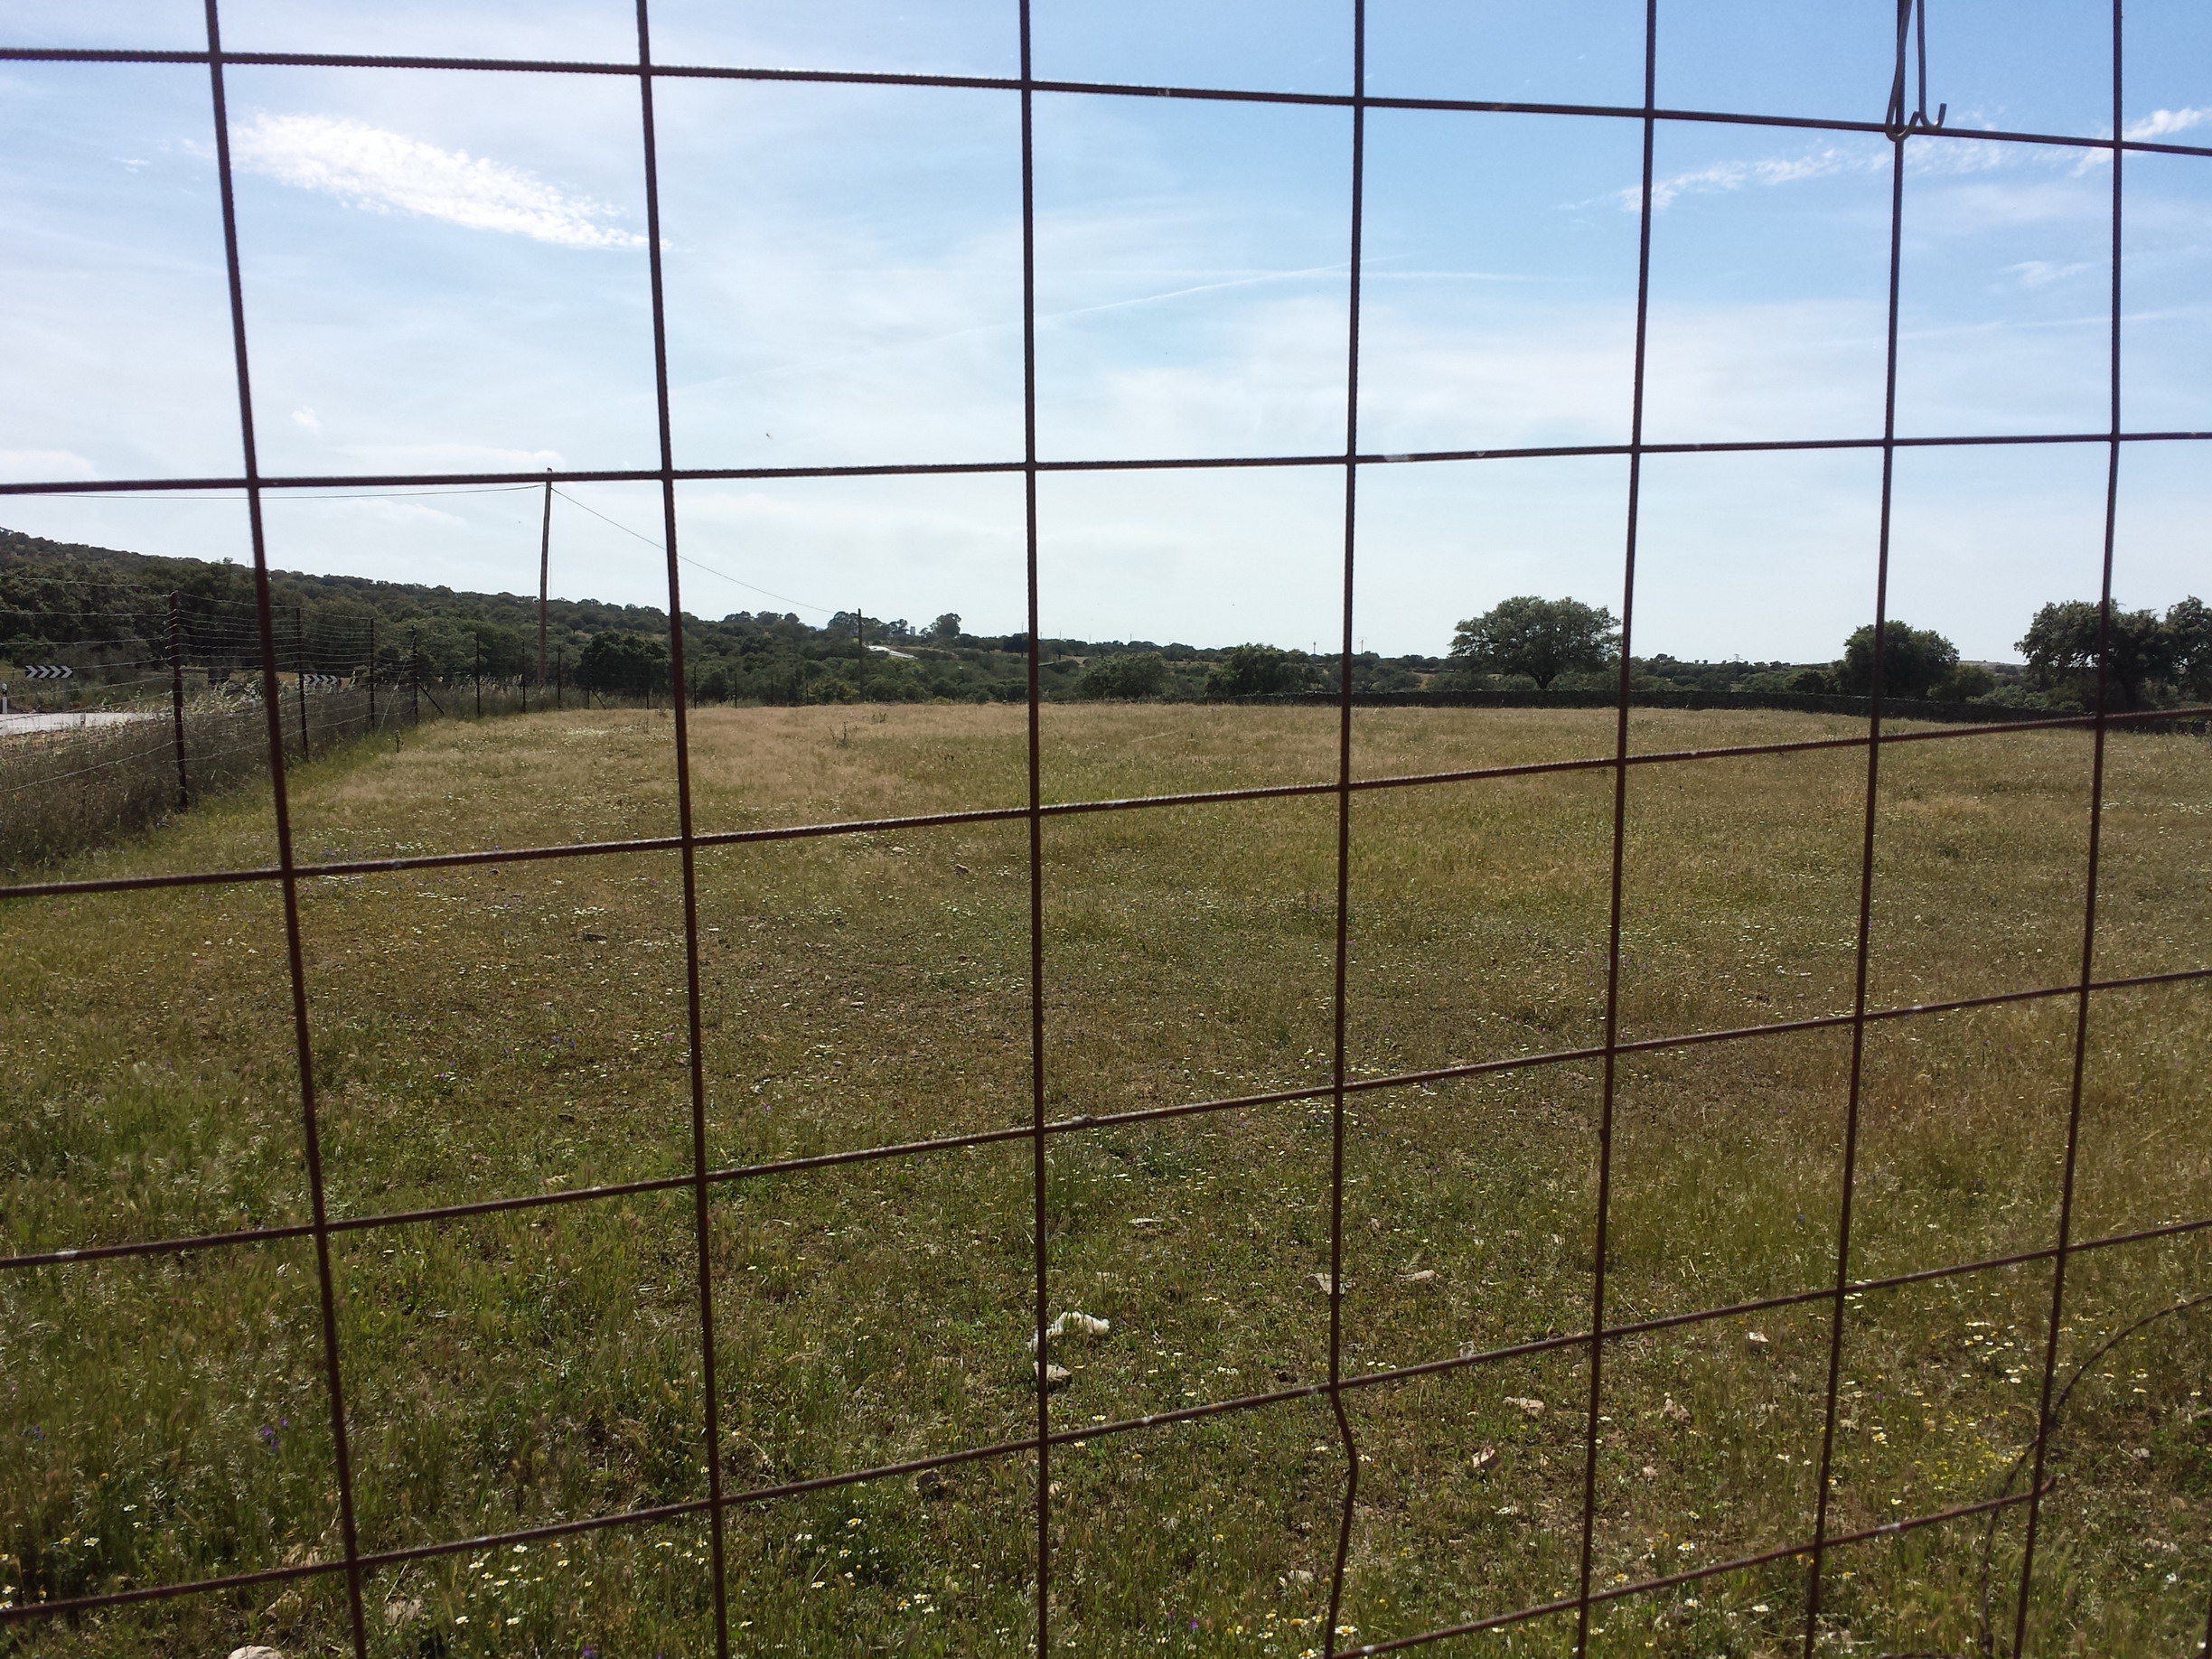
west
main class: Woodland
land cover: Broadleaved woodland
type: broadleaved evergreen forest
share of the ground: 25 - 50 %
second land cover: Grassland without tree/shrub cover
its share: > 75 %
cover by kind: herbaceous plants 65 %, broadleaved forest trees 35 %
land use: Forestry
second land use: Agriculture (excluding fallow land and kitchen gardens)
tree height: > 5 m
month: May
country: ES
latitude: 39.5152
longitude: -7.1726
